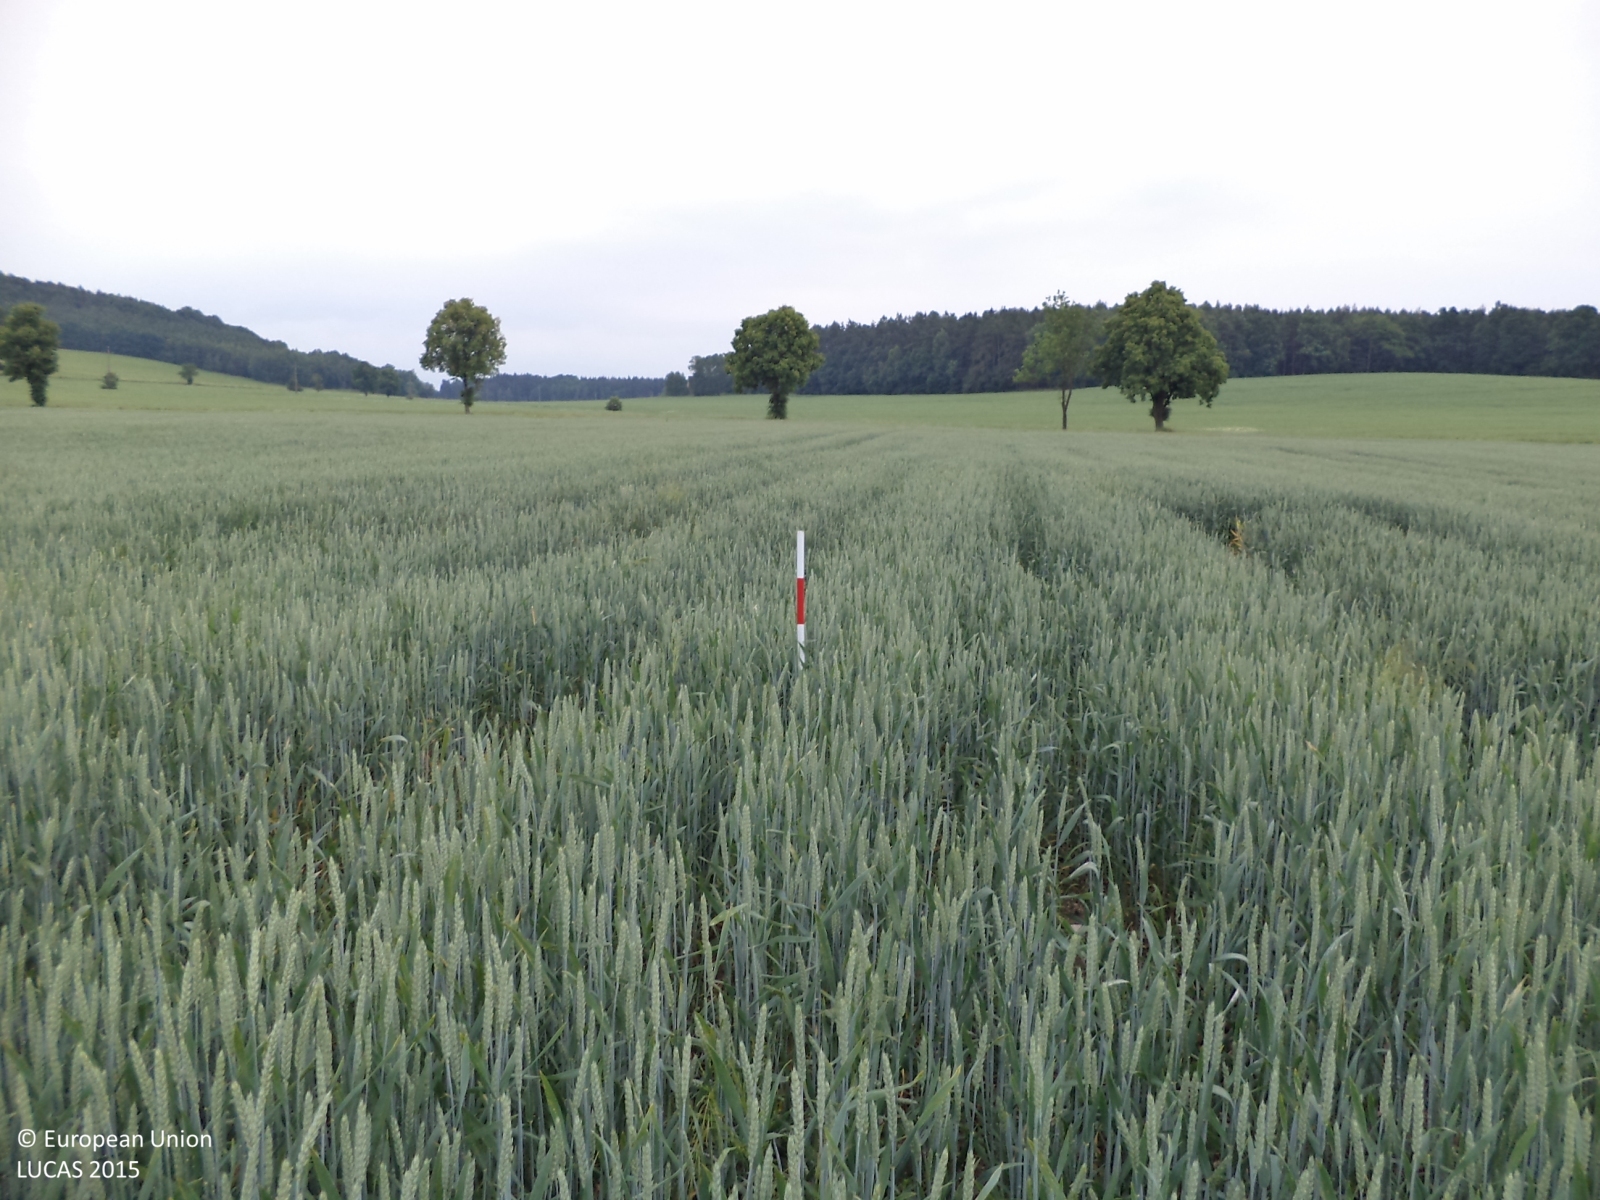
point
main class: Cropland
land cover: Common wheat
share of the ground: > 75 %
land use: Agriculture (excluding fallow land and kitchen gardens)
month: June
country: CZ
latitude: 49.1859
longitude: 14.2679
